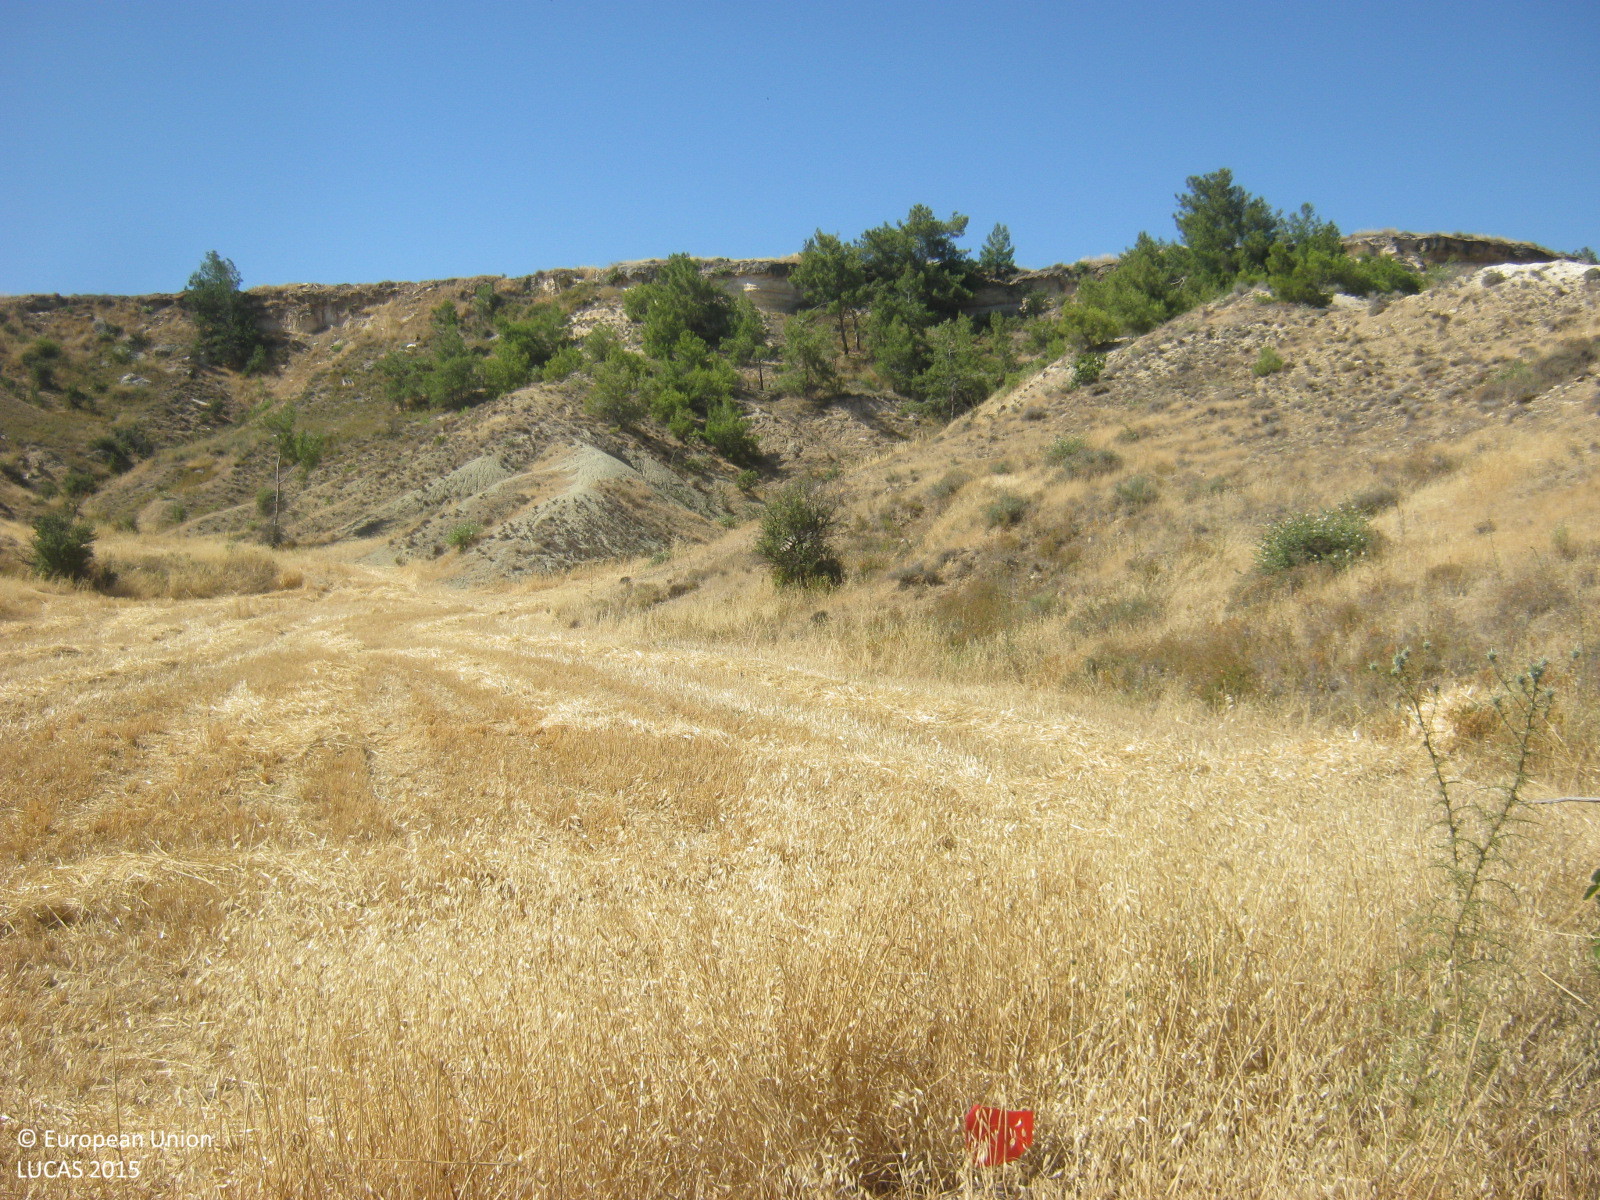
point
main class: Grassland
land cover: Spontaneously vegetated surfaces
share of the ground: > 75 %
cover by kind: herbaceous plants 85 %, unconsolidated bare surface 10 %, shrubs 5 %
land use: Semi-natural and natural areas not in use
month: June
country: CY
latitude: 35.0498
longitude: 33.1726
